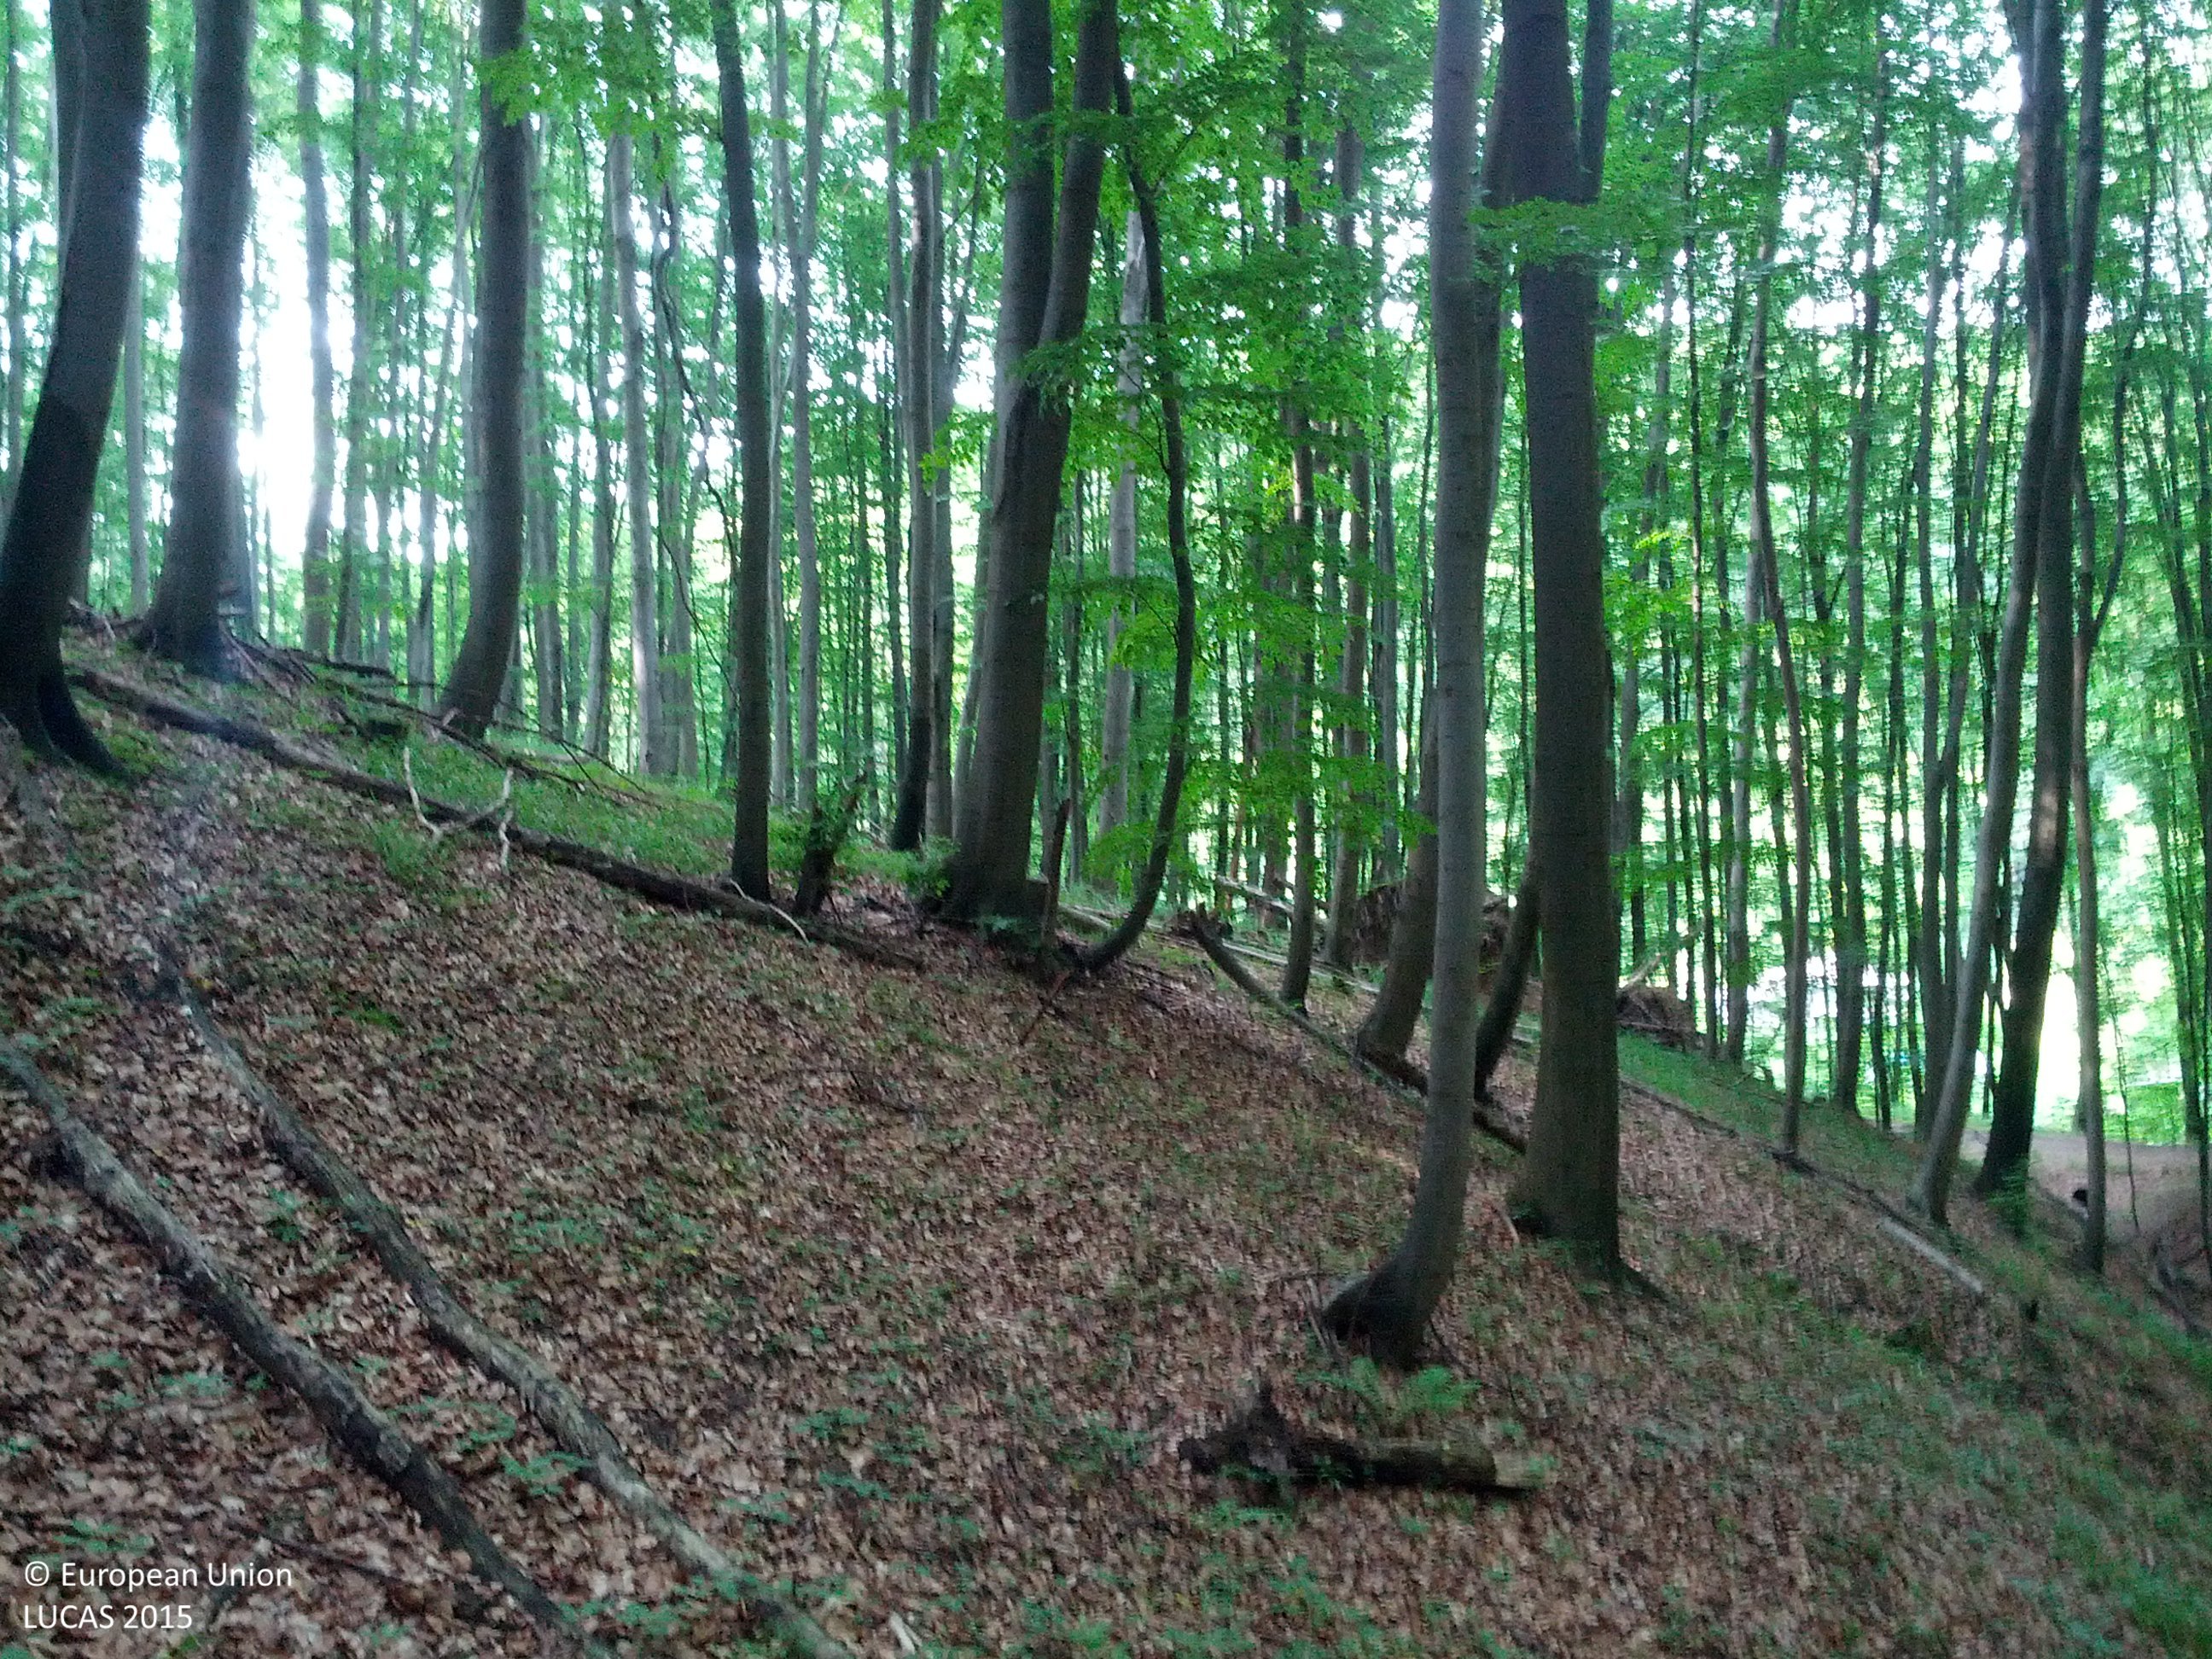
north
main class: Woodland
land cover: Broadleaved woodland
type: beech forest
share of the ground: > 75 %
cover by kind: broadleaved forest trees 95 %, herbaceous plants 5 %
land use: Forestry
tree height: > 5 m
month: May
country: AT
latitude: 48.2632
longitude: 16.2418
